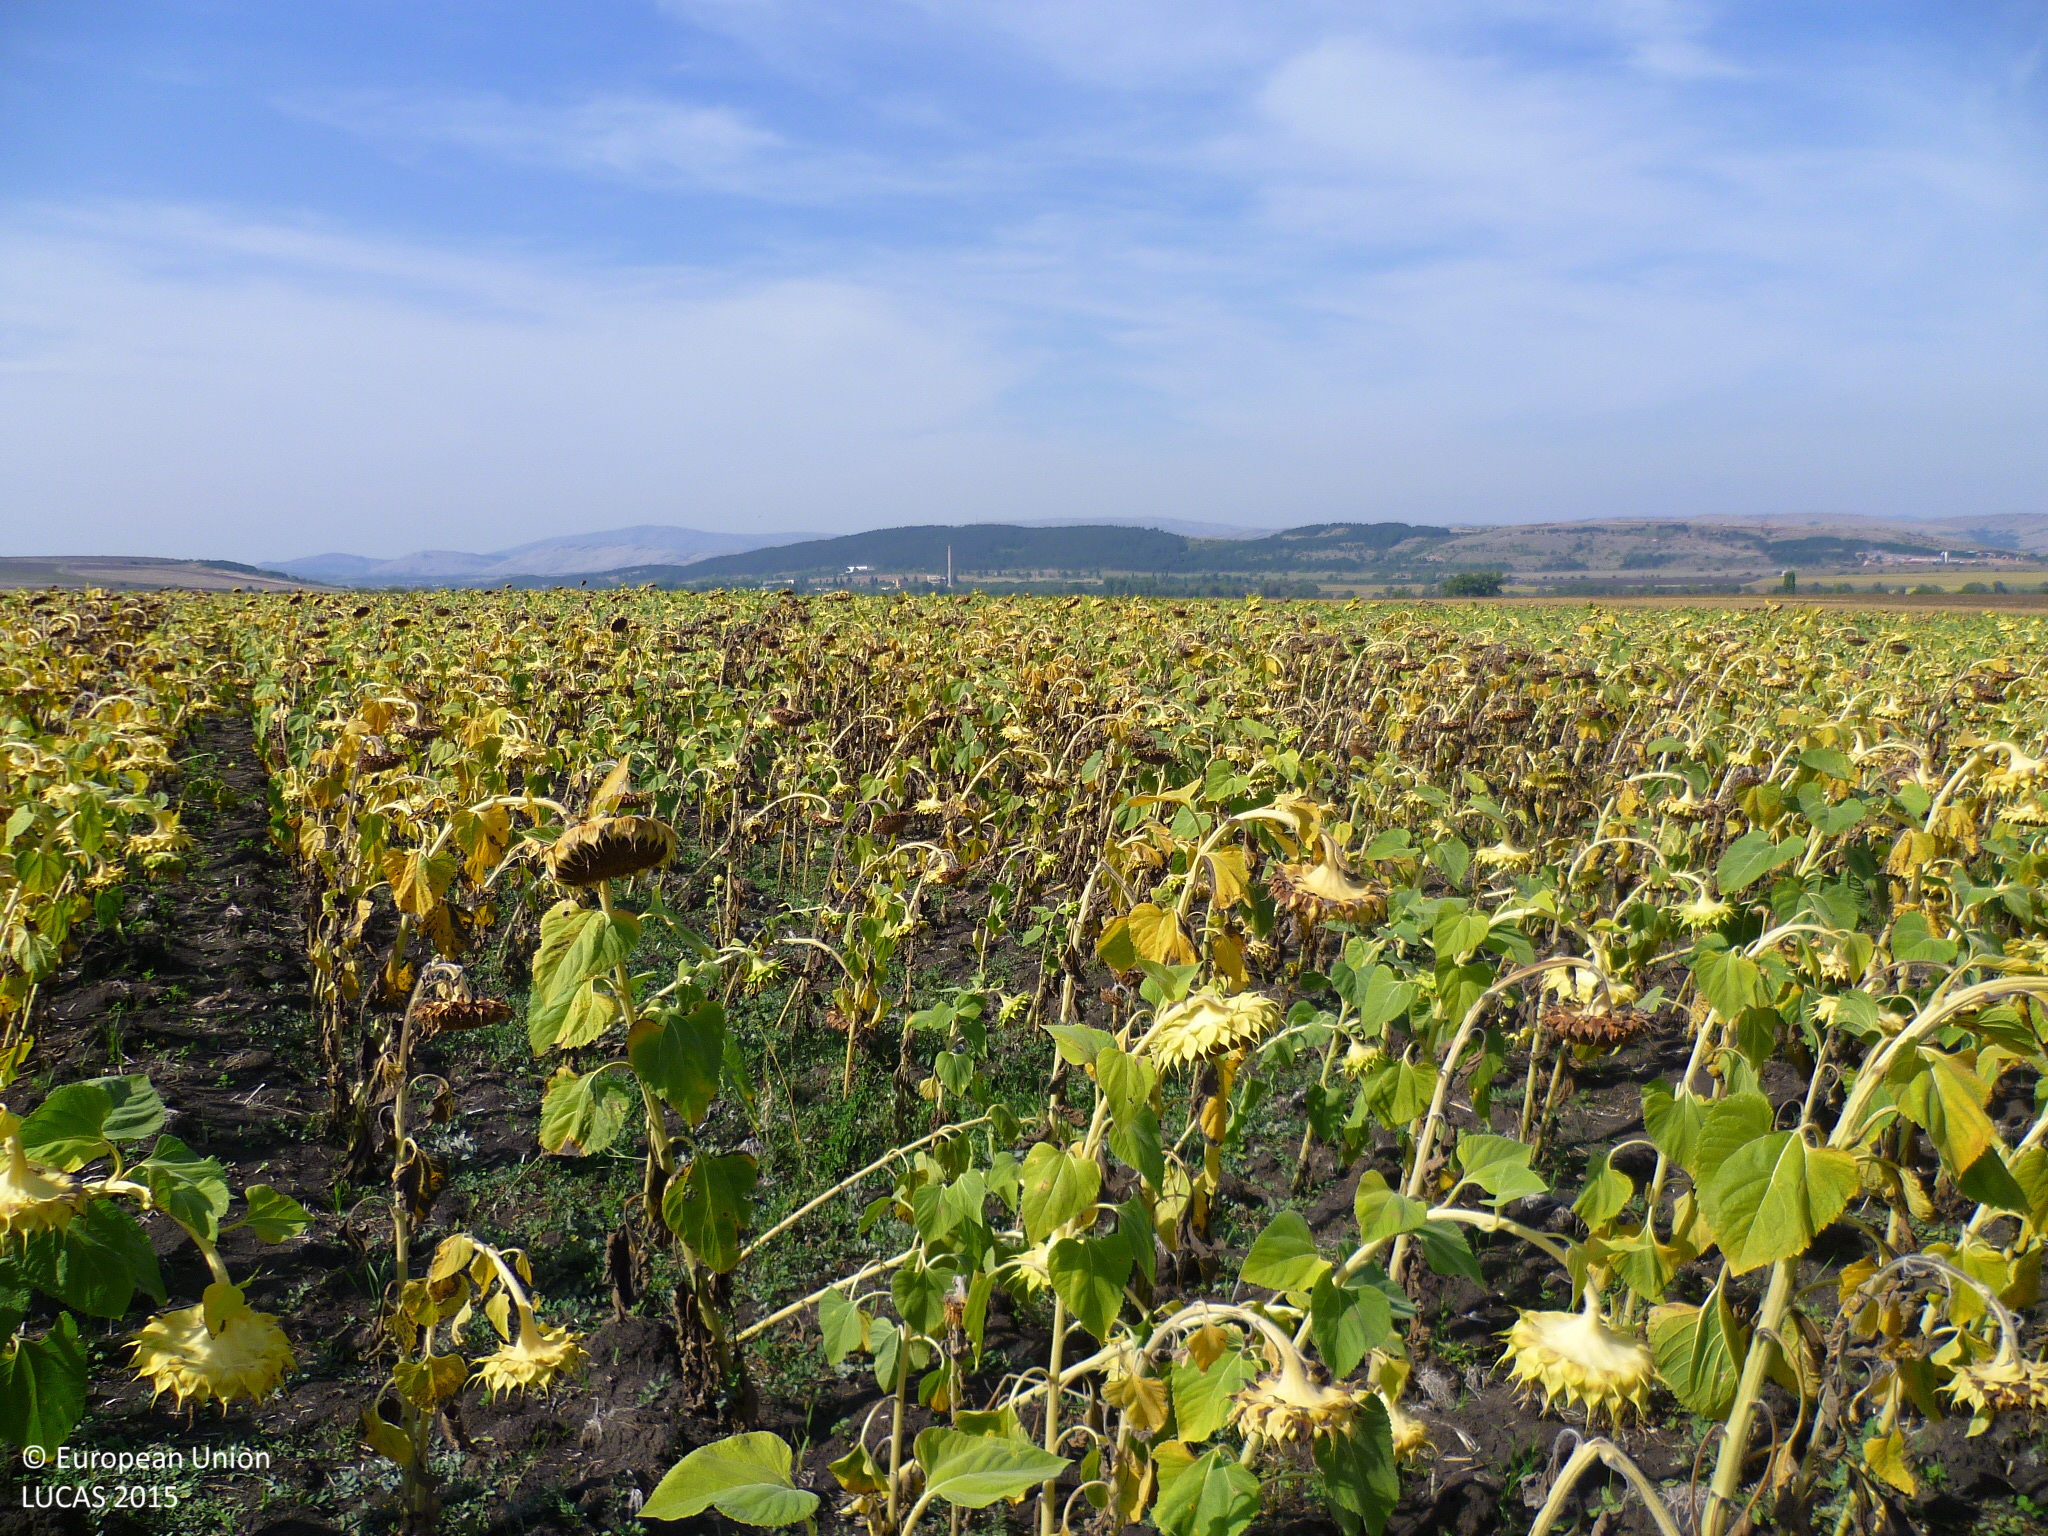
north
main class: Cropland
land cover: Sunflower
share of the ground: > 75 %
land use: Agriculture (excluding fallow land and kitchen gardens)
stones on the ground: < 10 %
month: December
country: BG
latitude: 42.8243
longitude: 23.0836
